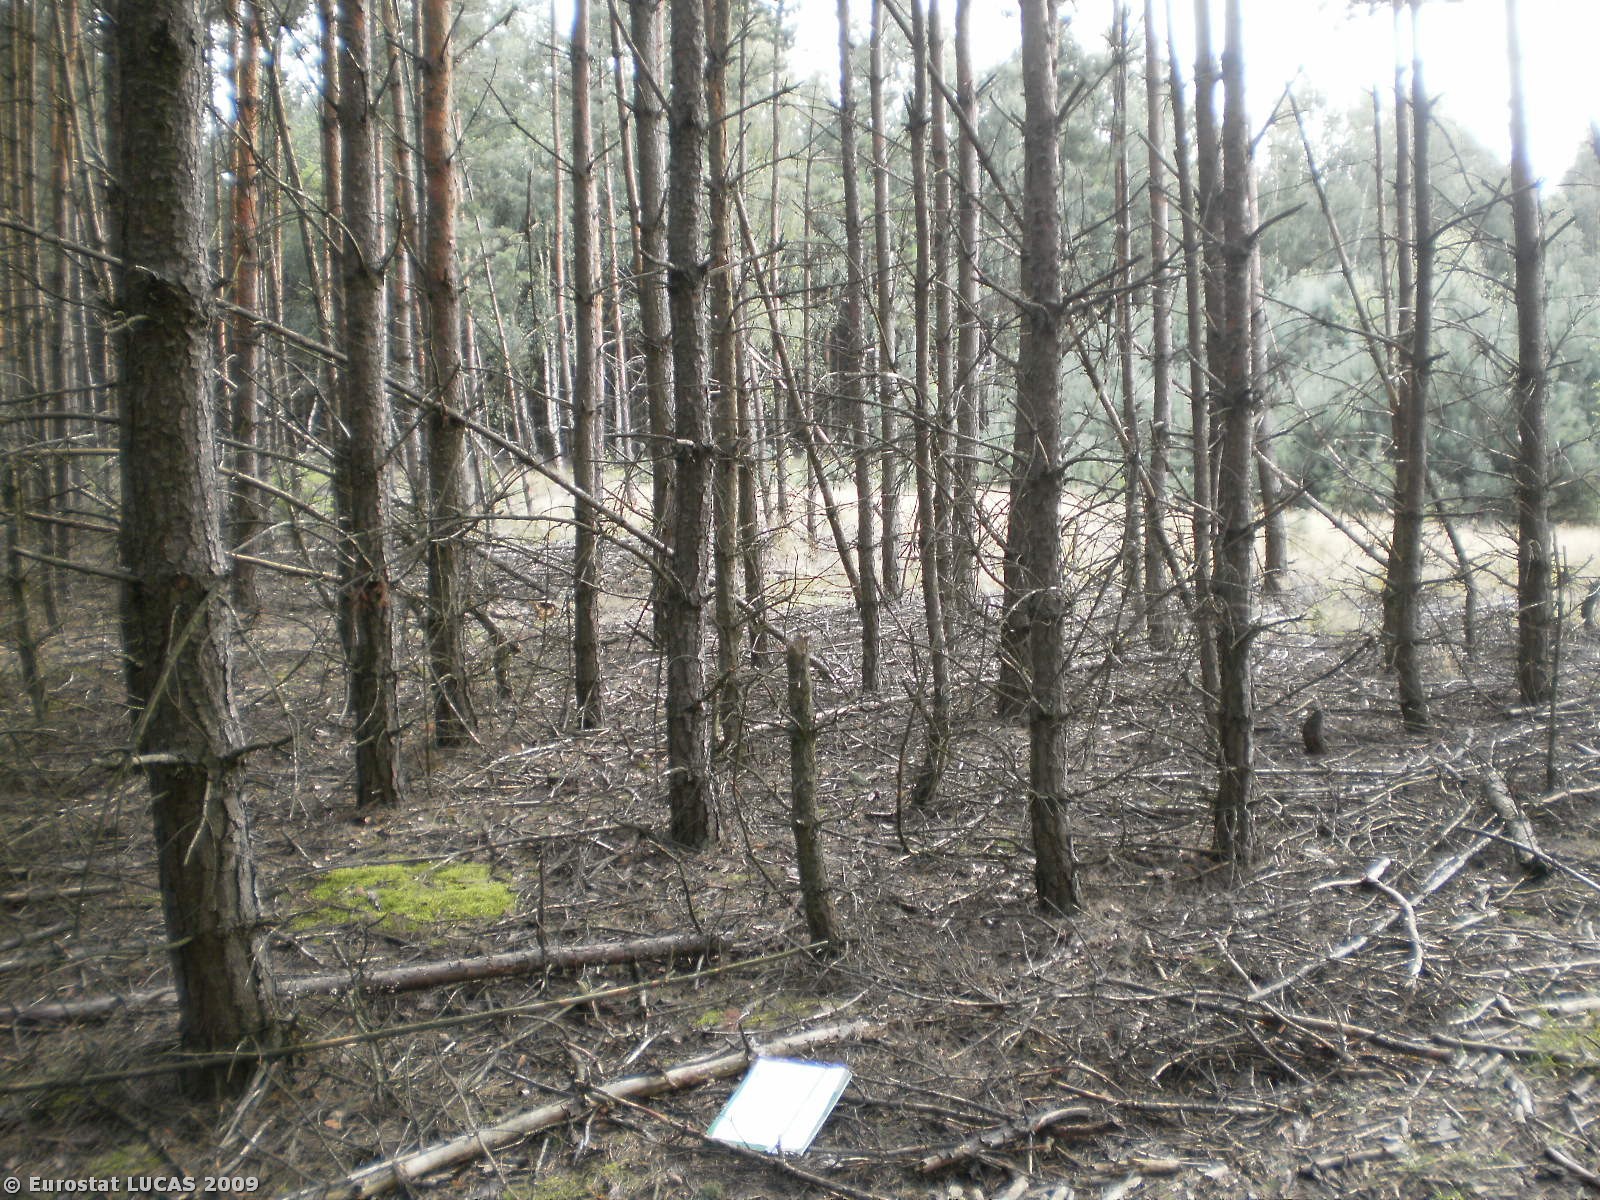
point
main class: Woodland
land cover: Coniferous woodland
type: hemiboreal forest and nemoral coniferous forest and mixed broadleaved-coniferous forest
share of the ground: > 75 %
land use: Forestry
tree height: > 5 m
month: August
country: PL
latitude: 52.8586
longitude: 21.8031
